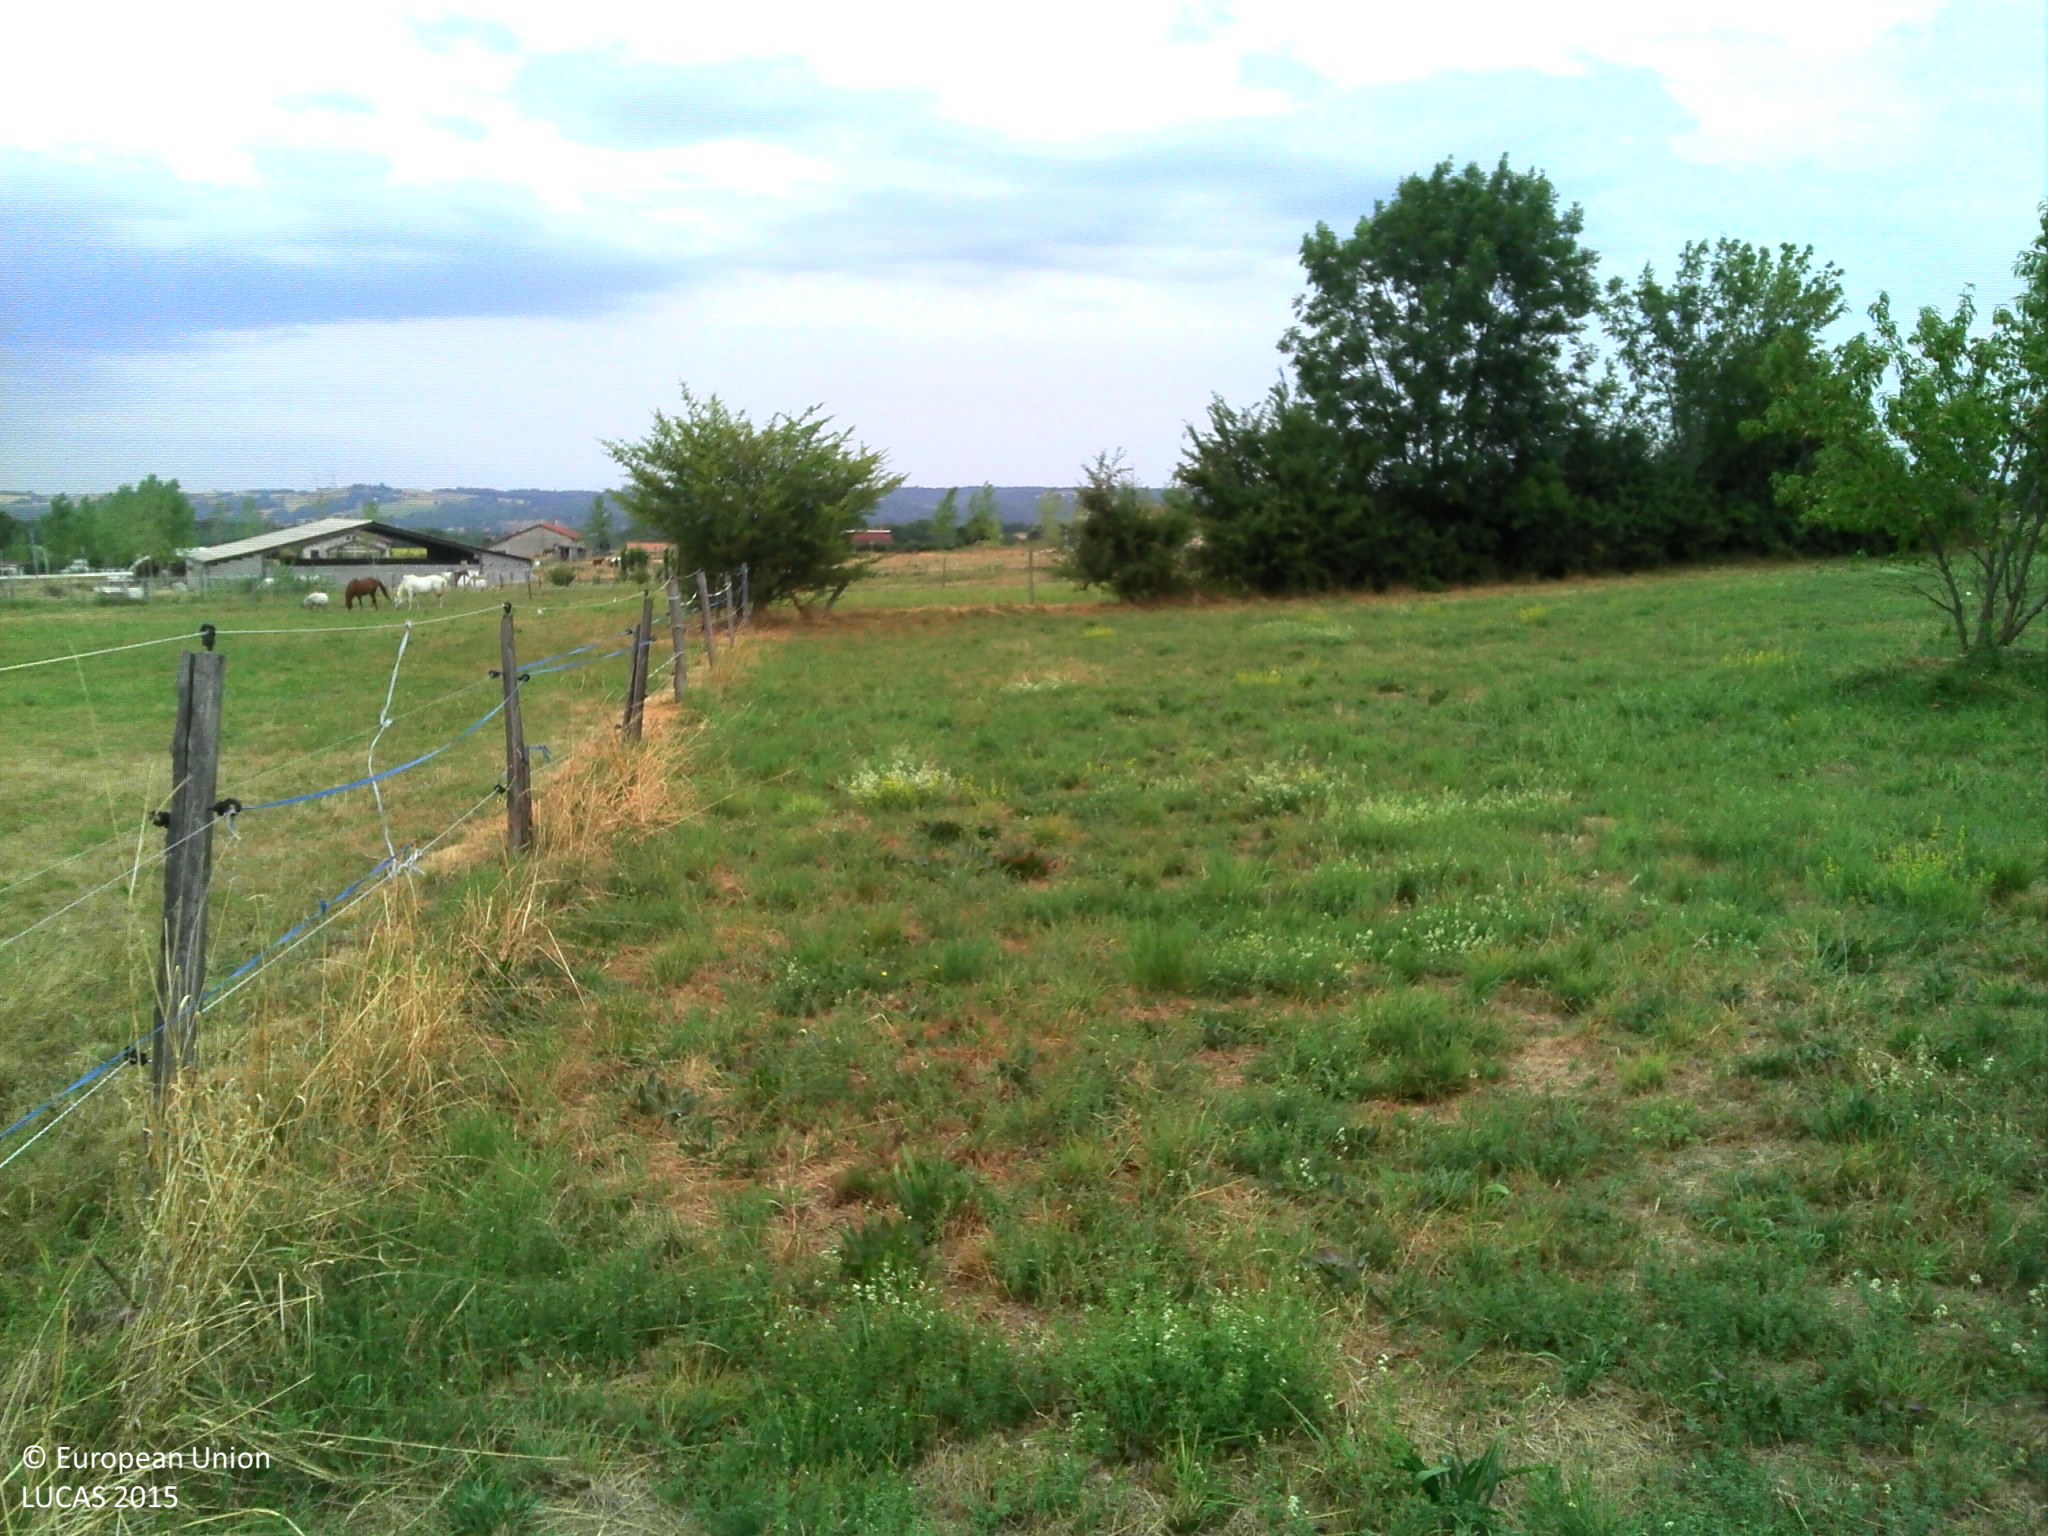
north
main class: Grassland
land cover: Grassland without tree/shrub cover
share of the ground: > 75 %
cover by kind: herbaceous plants 100 %
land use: Agriculture (excluding fallow land and kitchen gardens)
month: July
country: FR
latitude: 45.4751
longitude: 4.9771
